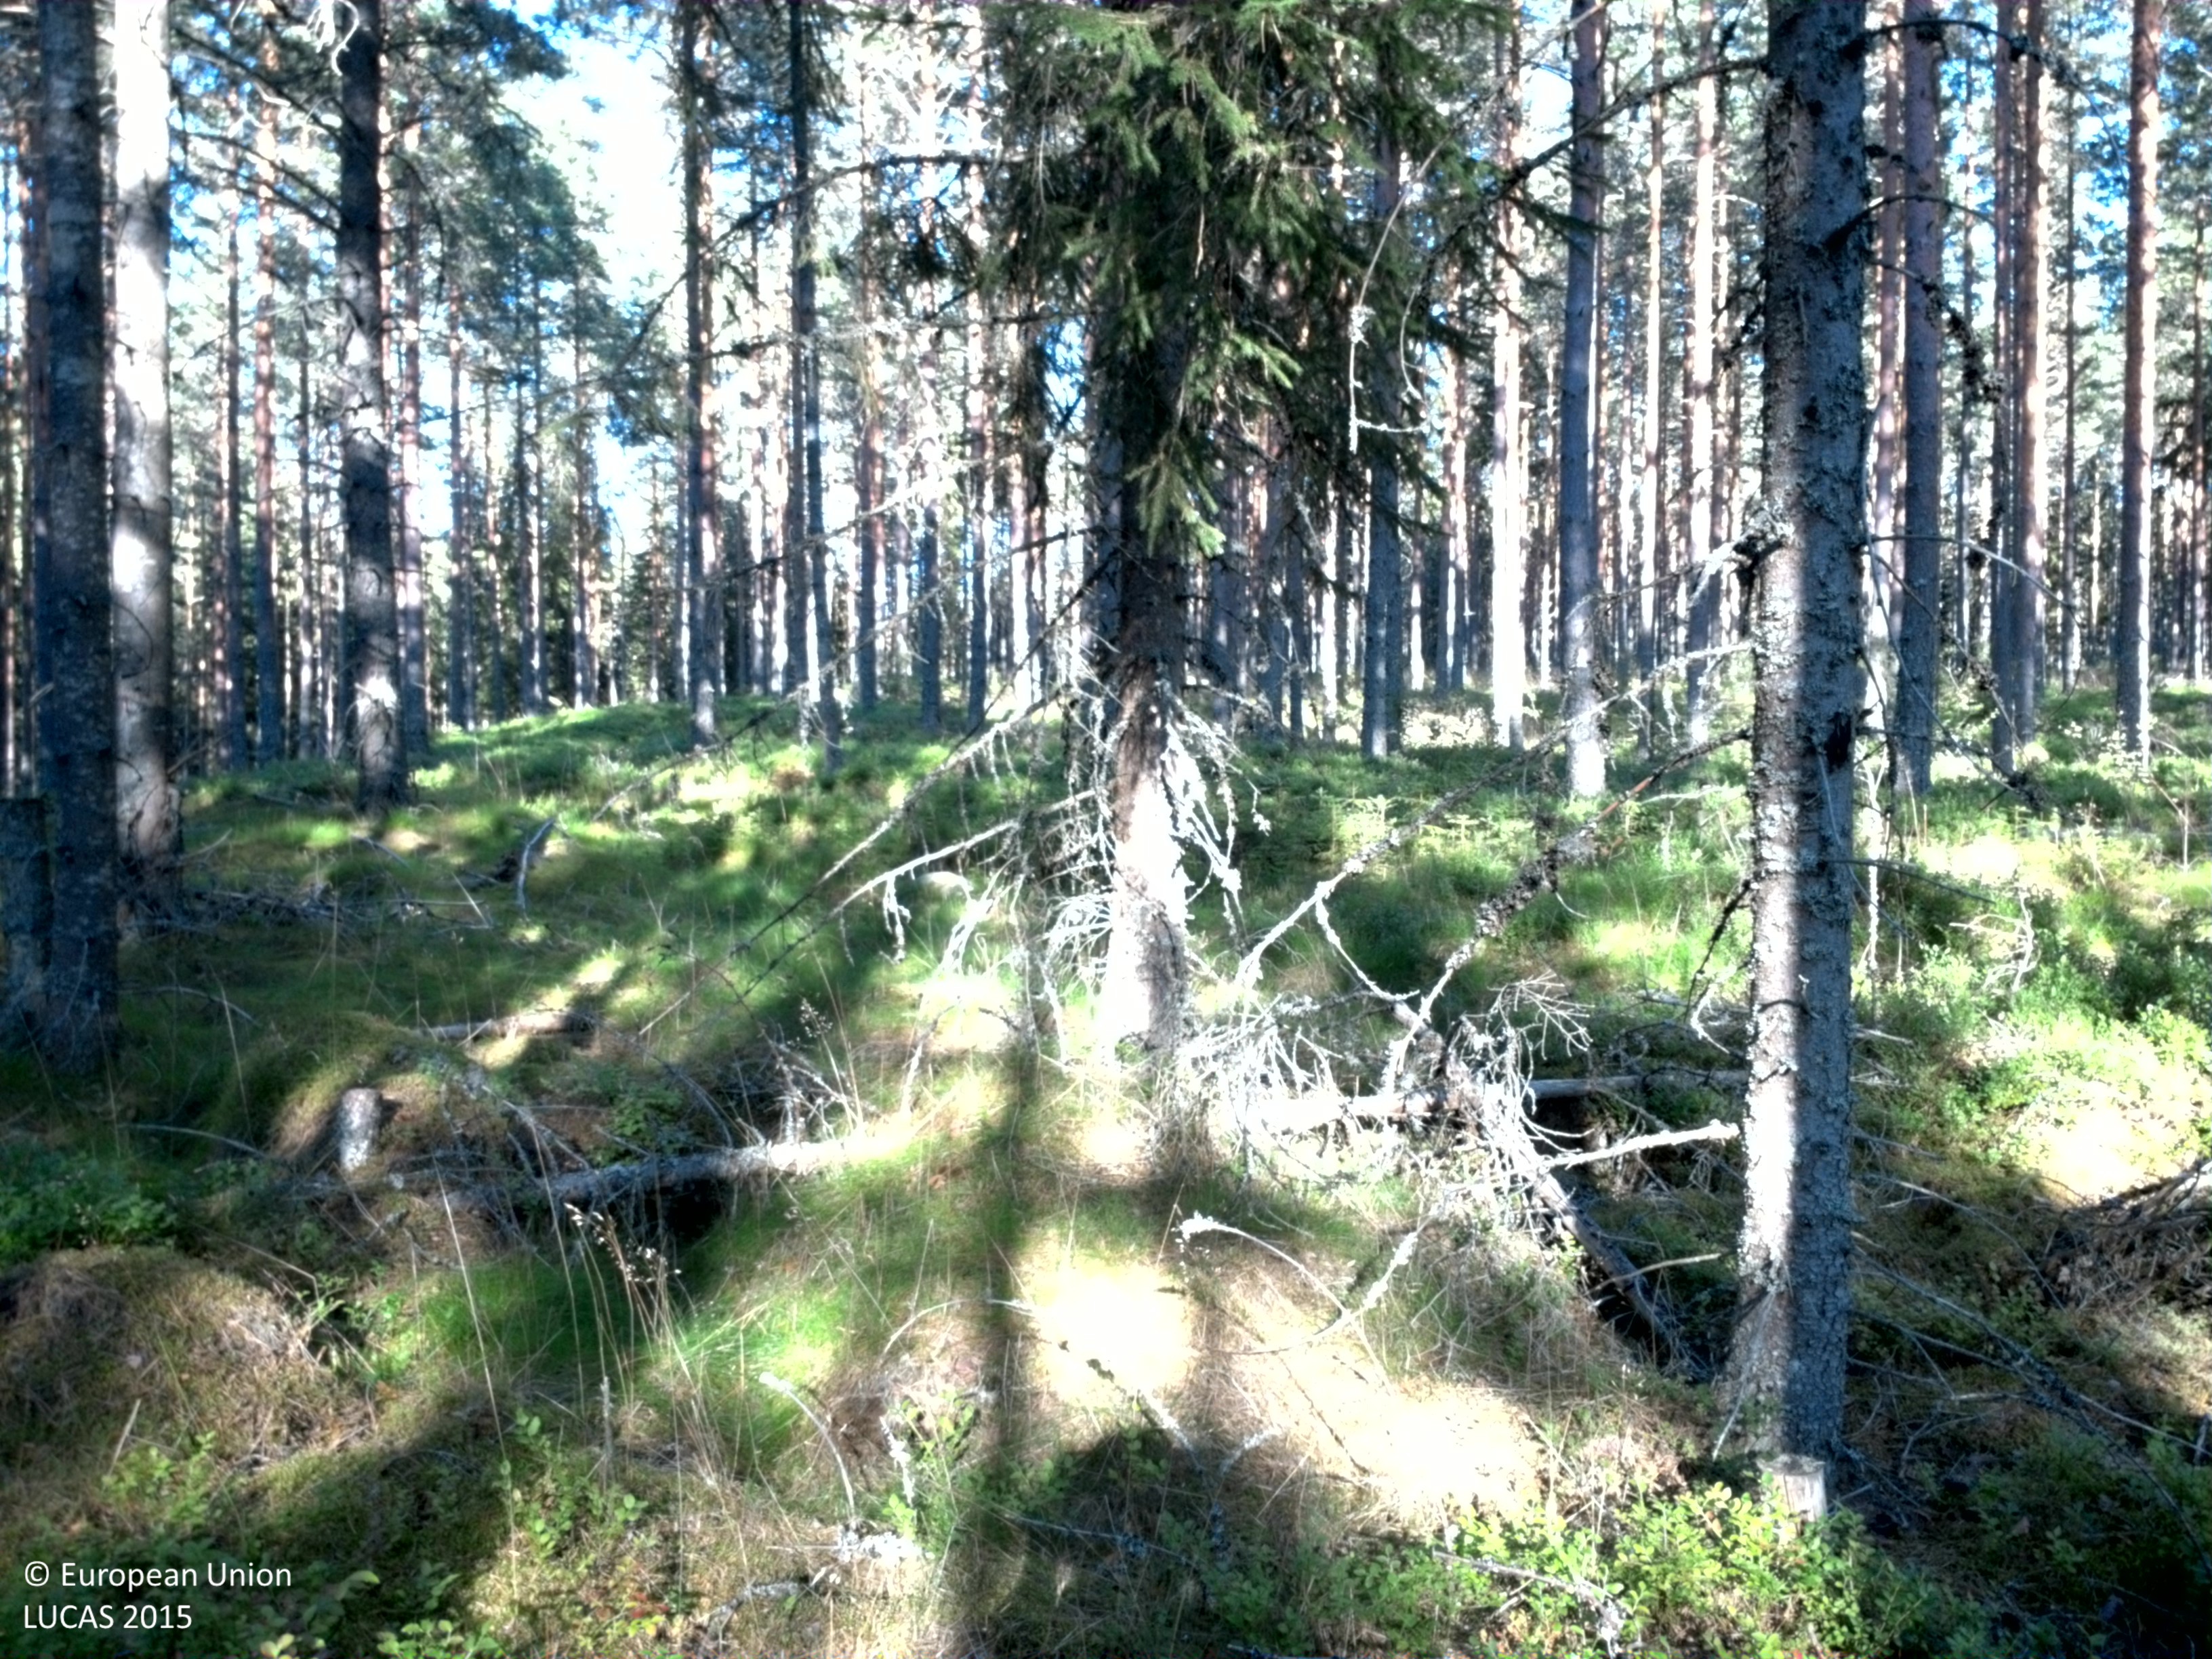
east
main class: Woodland
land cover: Pine dominated coniferous woodland
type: boreal forest
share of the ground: 50 - 75 %
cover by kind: coniferous forest trees 70 %, shrubs 25 %, lichens and mosses 5 %
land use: Forestry
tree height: > 5 m
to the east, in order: Pine dominated coniferous woodland; Tracks; Pine dominated coniferous woodland
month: August
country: SE
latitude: 60.1902
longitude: 13.5430
